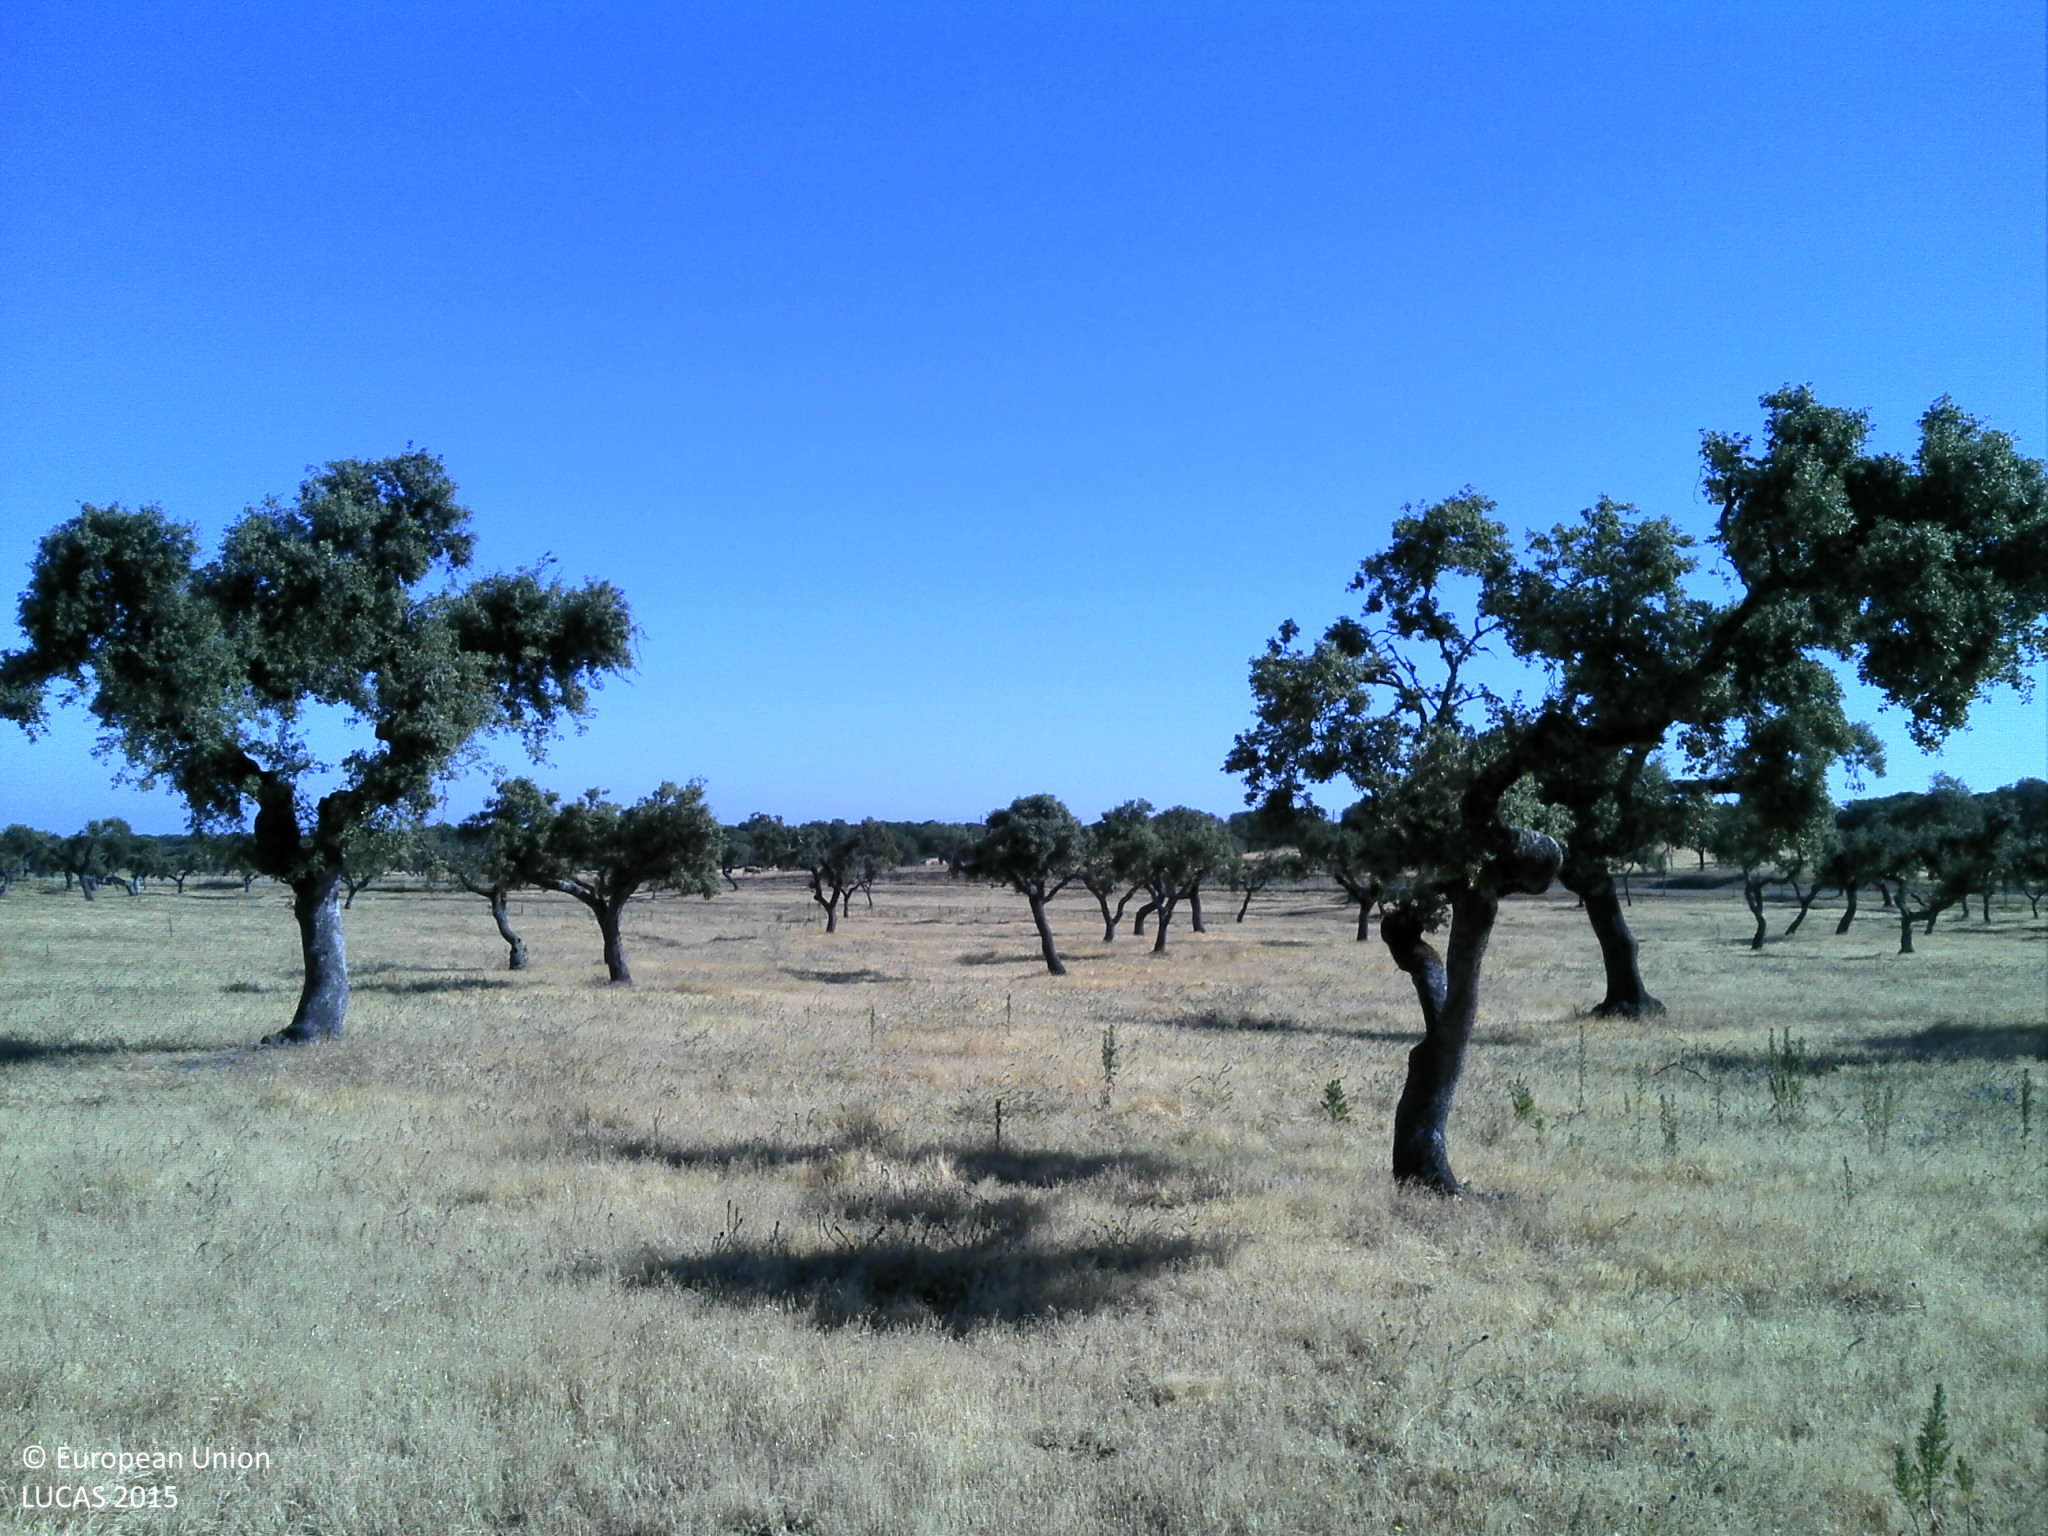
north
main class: Woodland
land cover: Broadleaved woodland
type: broadleaved evergreen forest
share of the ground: 25 - 50 %
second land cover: Grassland without tree/shrub cover
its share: 50 - 75 %
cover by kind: herbaceous plants 50 %, broadleaved forest trees 40 %, unconsolidated bare surface 10 %
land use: Forestry
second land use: Agriculture (excluding fallow land and kitchen gardens)
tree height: > 5 m
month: June
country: PT
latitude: 38.7704
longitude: -8.2012
